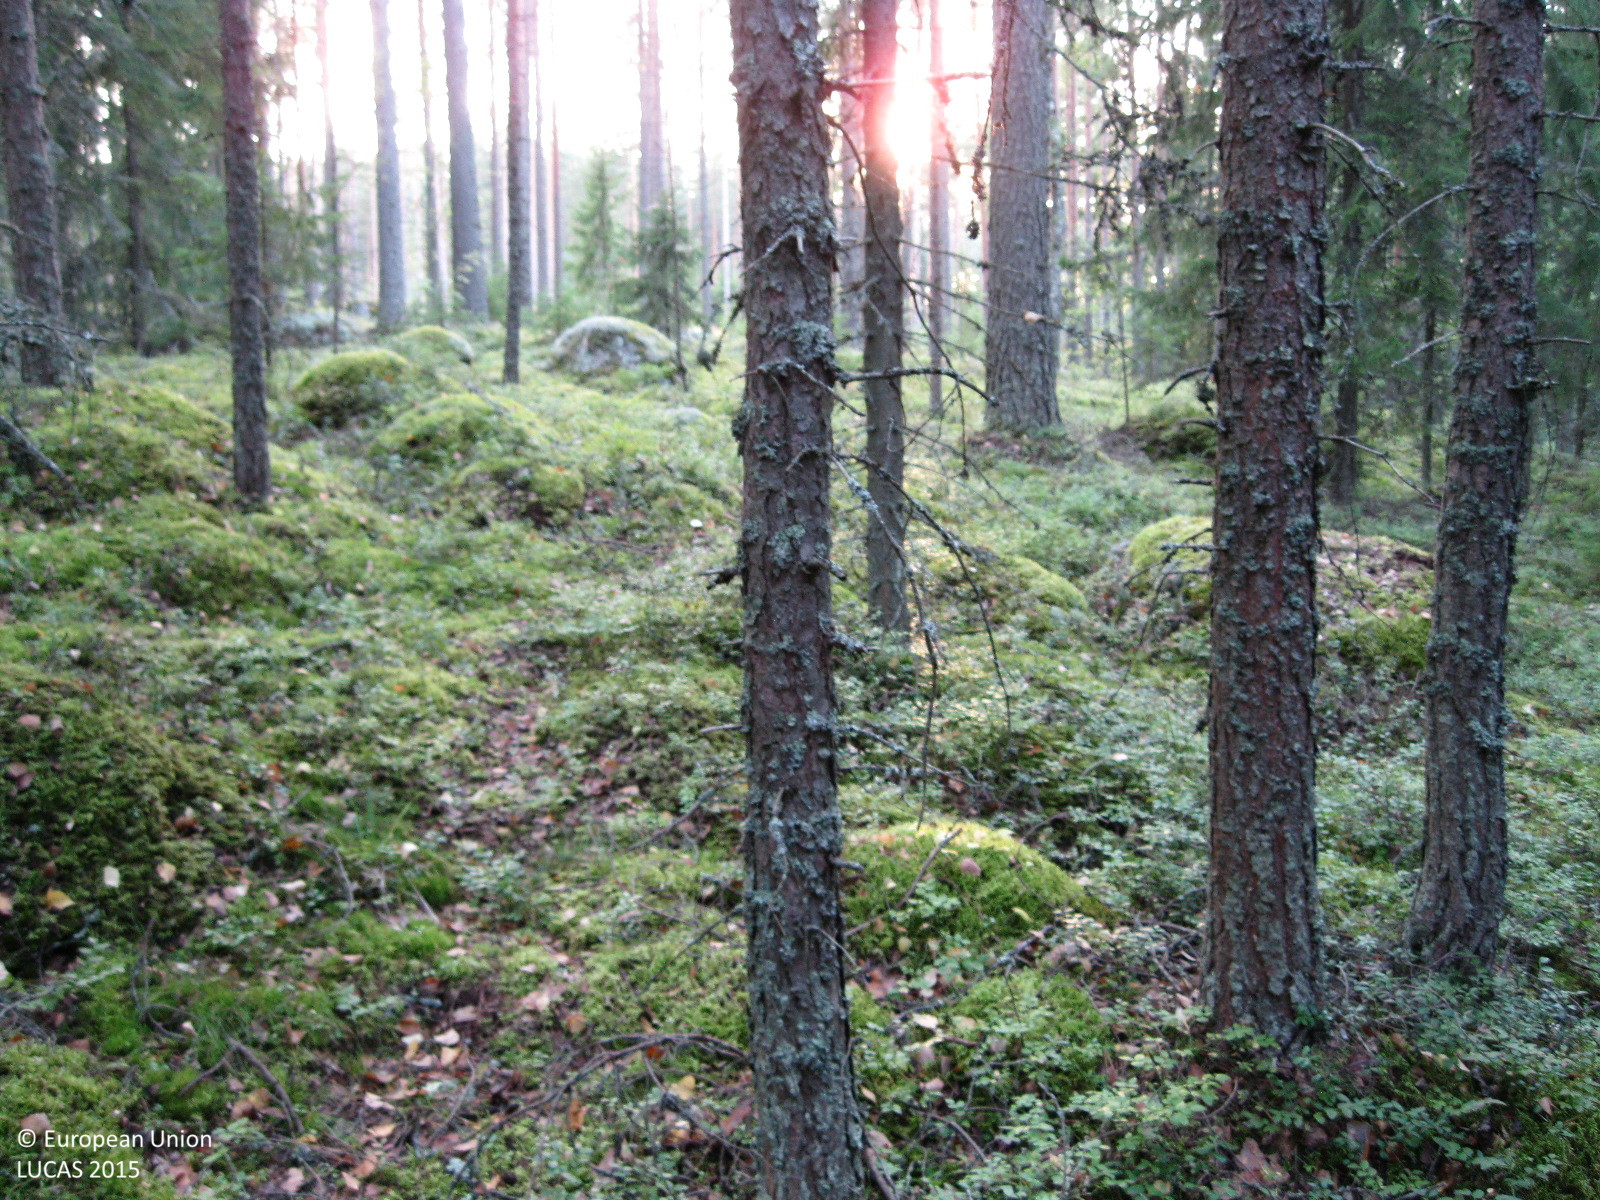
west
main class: Woodland
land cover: Other mixed woodland
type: boreal forest
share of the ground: > 75 %
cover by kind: coniferous forest trees 55 %, broadleaved forest trees 20 %, lichens and mosses 15 %, shrubs 10 %
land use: Forestry
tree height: > 5 m
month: September
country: FI
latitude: 60.7898
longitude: 24.9757
